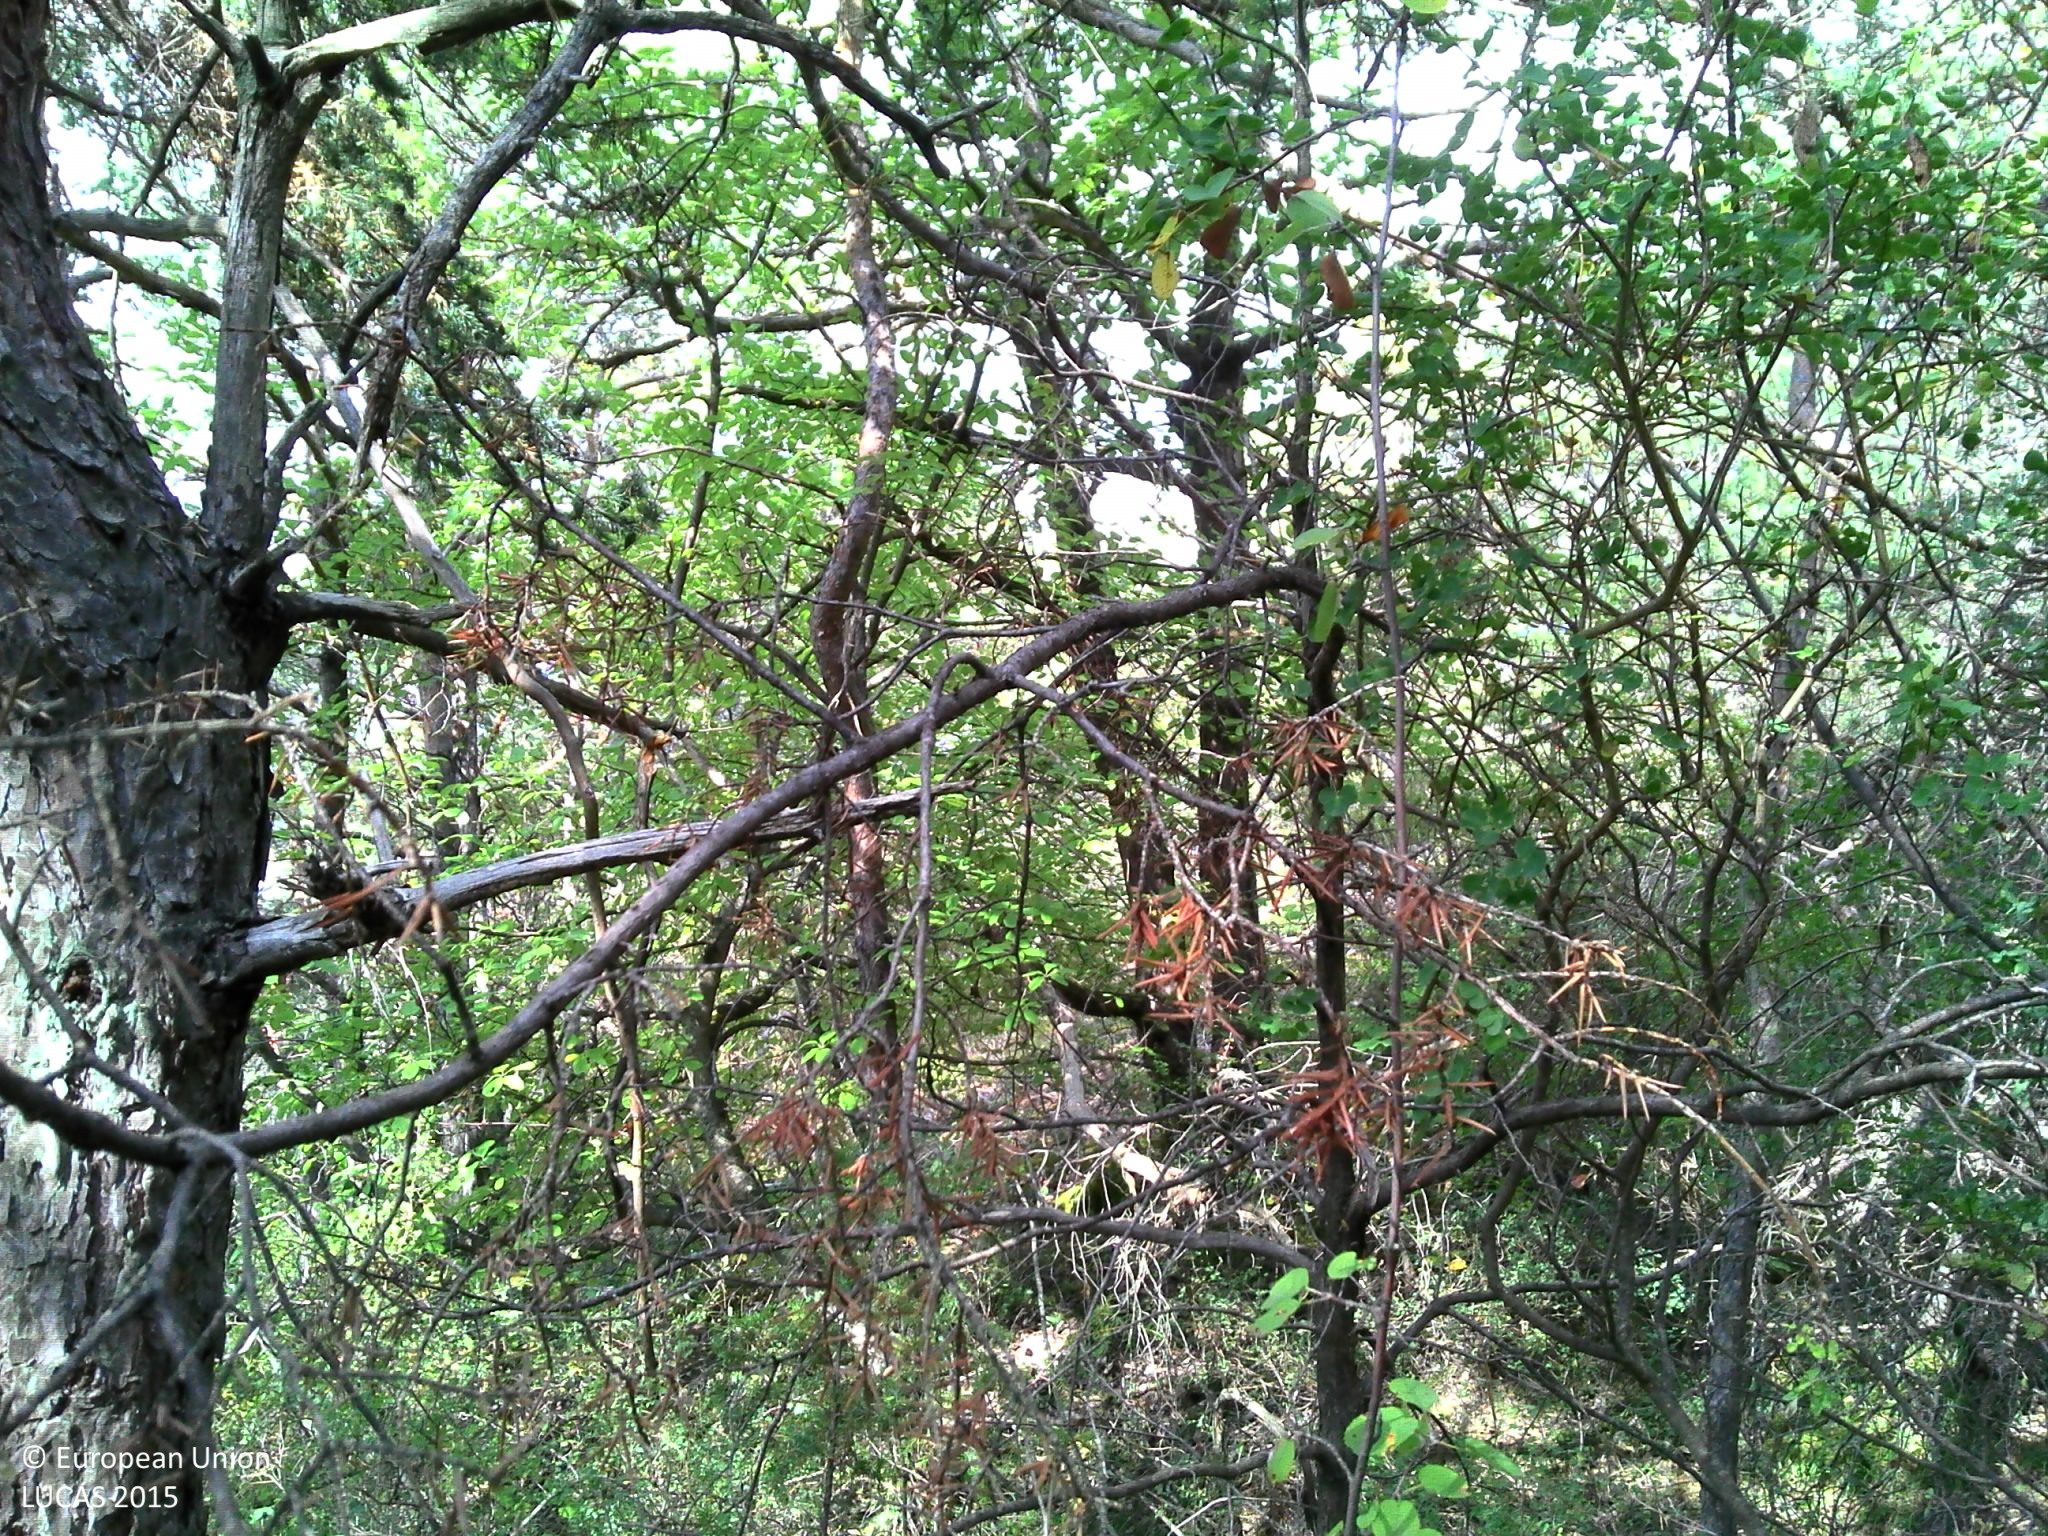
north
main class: Woodland
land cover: Pine dominated coniferous woodland
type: hemiboreal forest and nemoral coniferous forest and mixed broadleaved-coniferous forest
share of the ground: > 75 %
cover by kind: coniferous forest trees 70 %, broadleaved forest trees 10 %, shrubs 10 %, herbaceous plants 5 %, consolidated bare surface 5 %
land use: Forestry
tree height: > 5 m
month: September
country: FR
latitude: 44.5344
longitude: 6.2187
